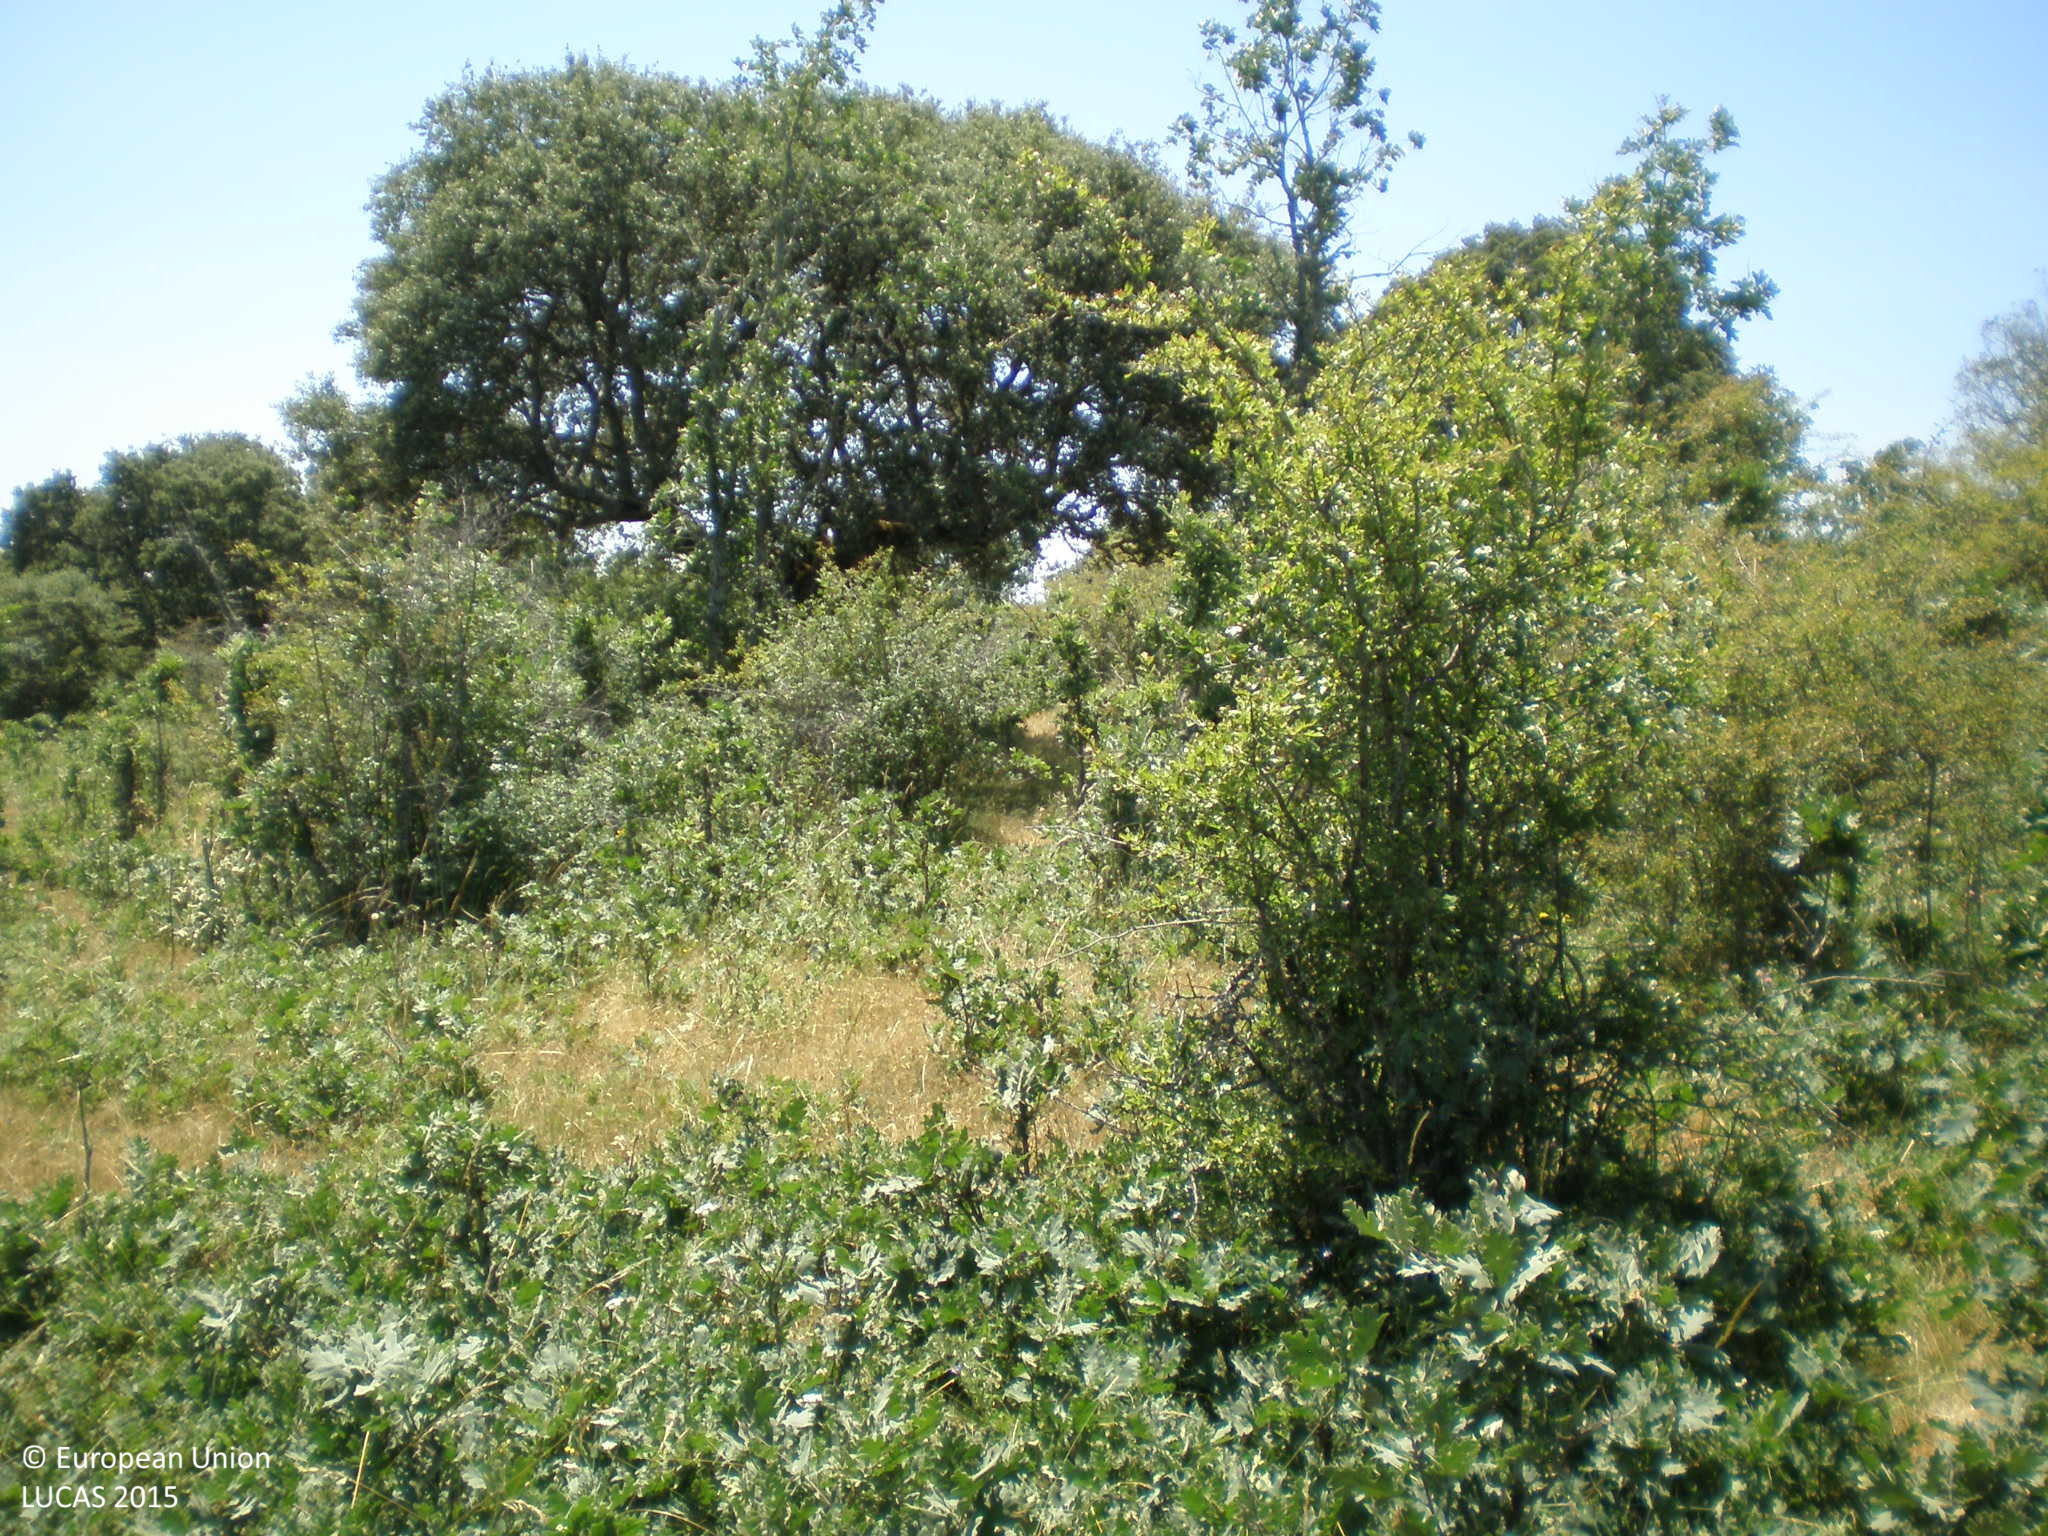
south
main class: Woodland
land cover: Broadleaved woodland
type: thermophilous deciduous forest
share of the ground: 50 - 75 %
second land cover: Grassland without tree/shrub cover
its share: 25 - 50 %
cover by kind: broadleaved forest trees 60 %, herbaceous plants 40 %
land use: Forestry
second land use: Agriculture (excluding fallow land and kitchen gardens)
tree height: > 5 m
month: June
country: ES
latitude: 40.6274
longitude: -5.8346
